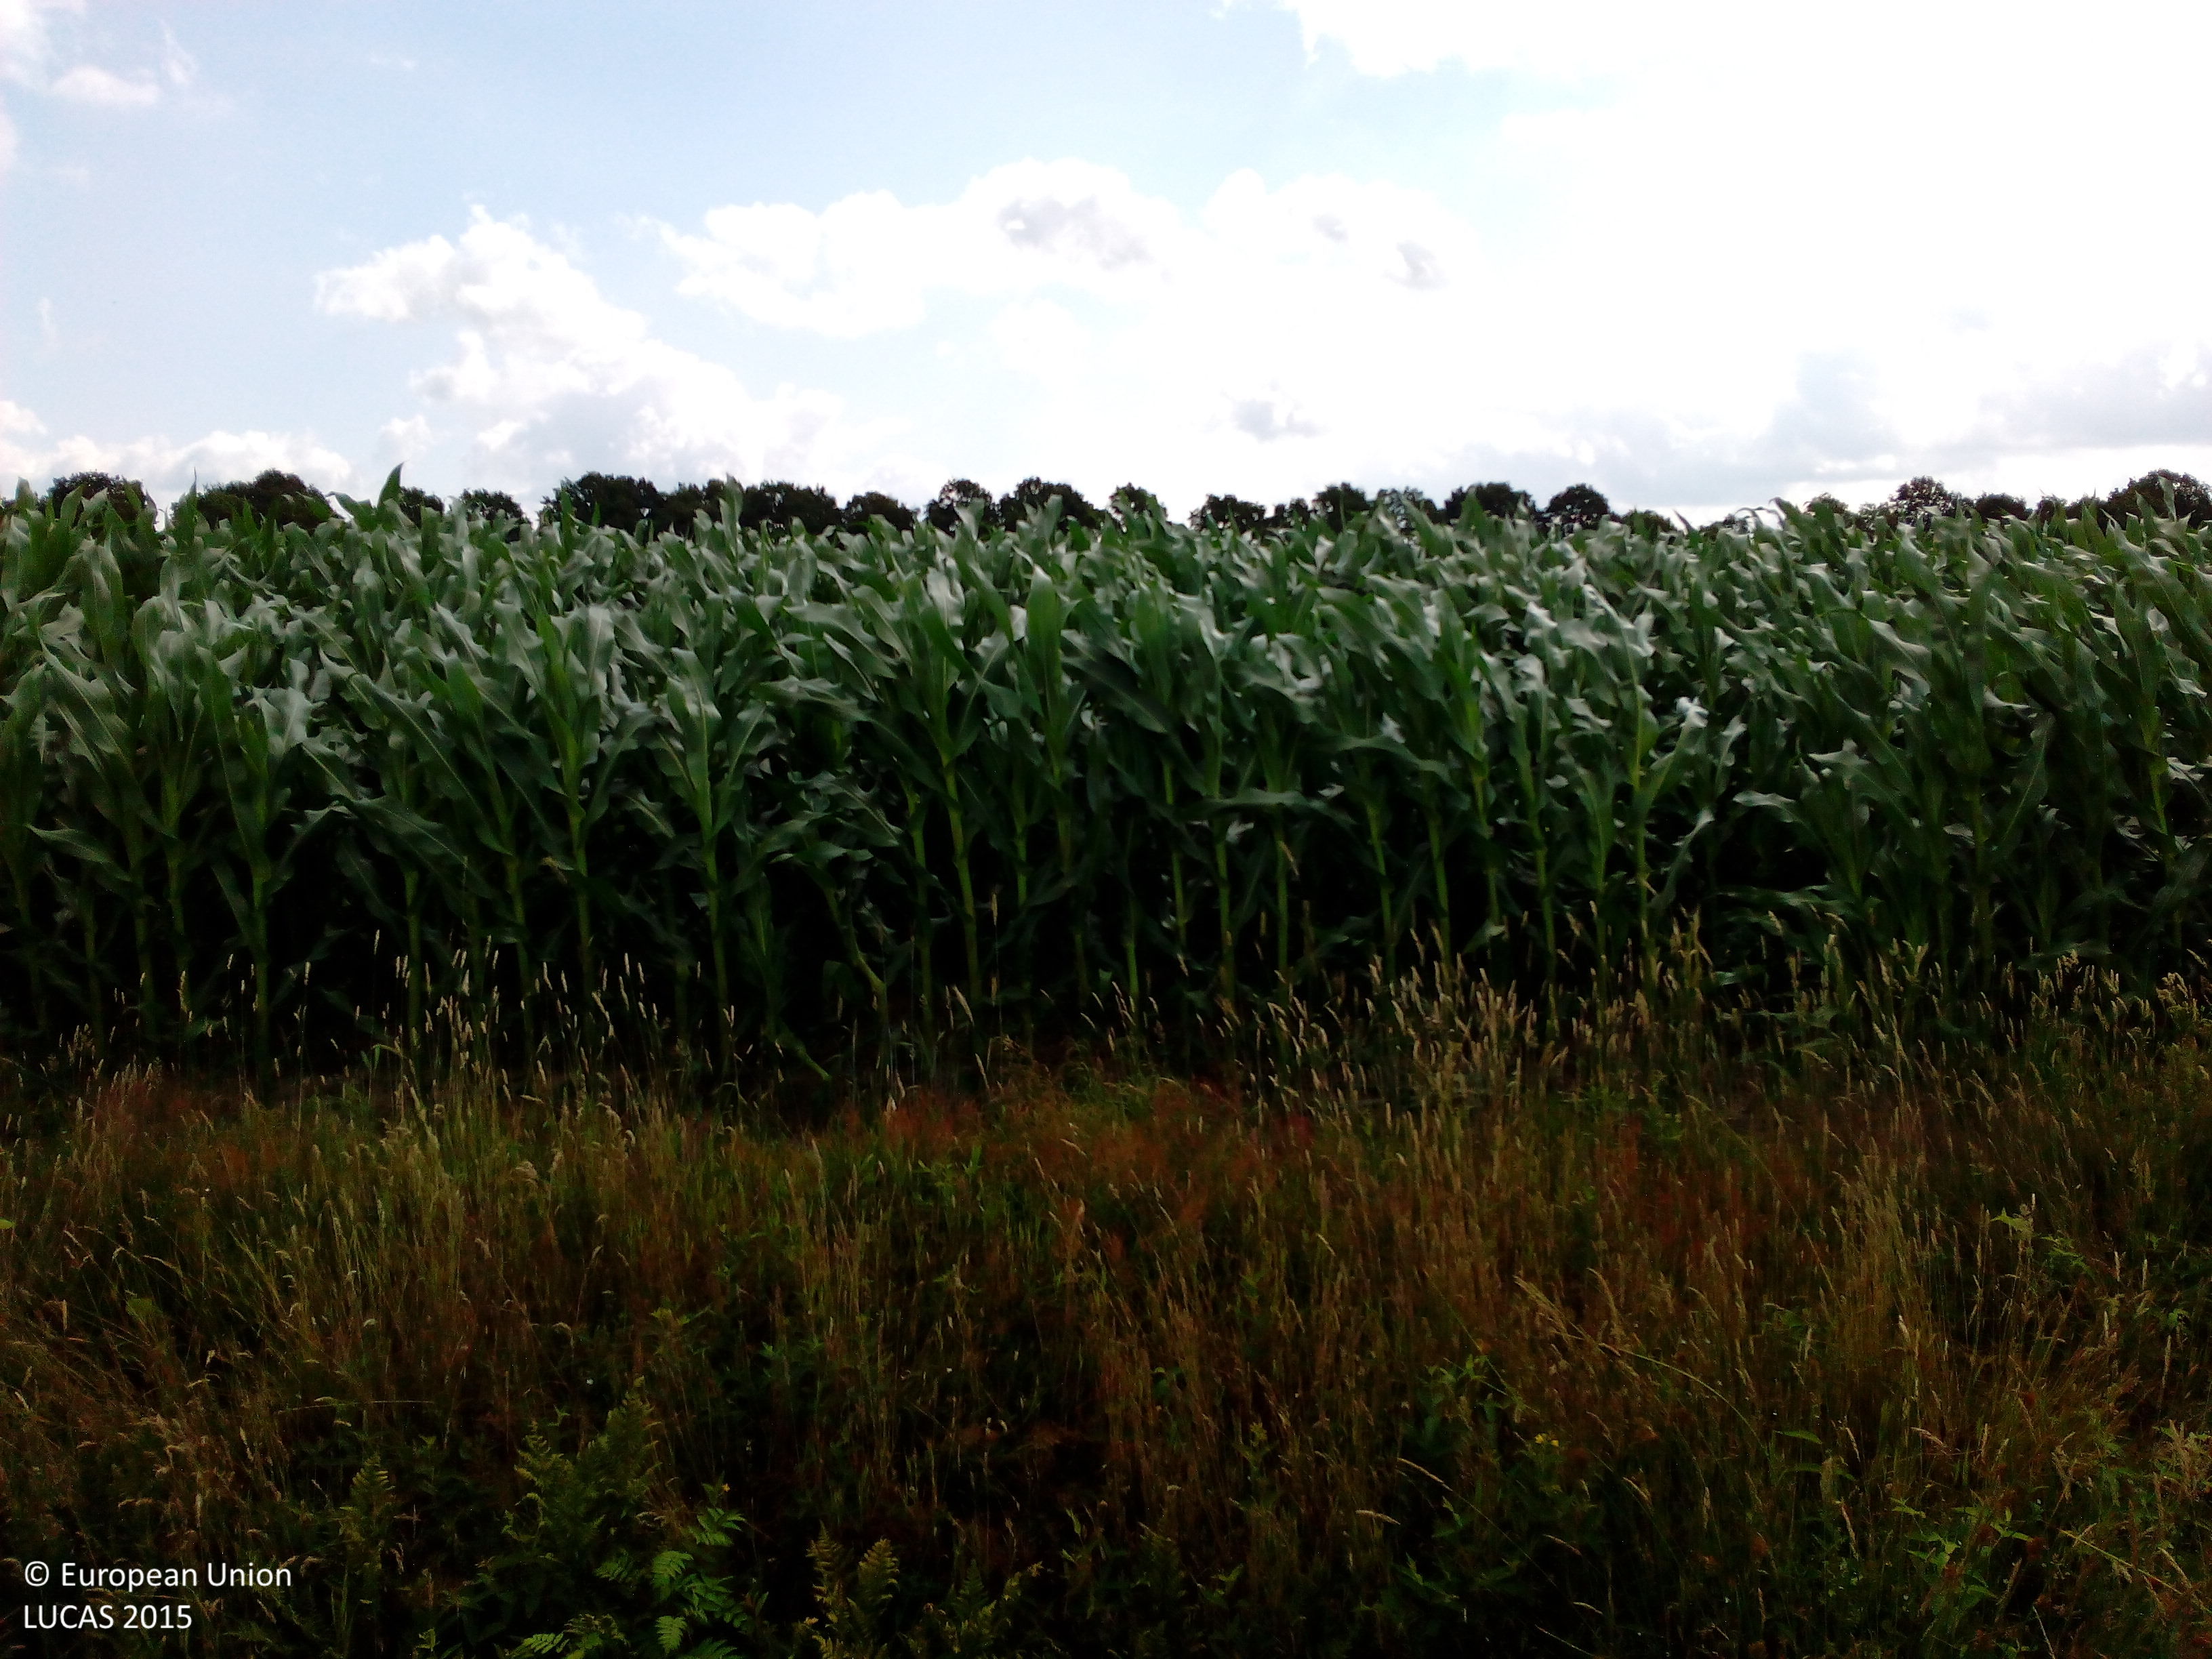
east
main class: Cropland
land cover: Barley
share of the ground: > 75 %
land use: Agriculture (excluding fallow land and kitchen gardens)
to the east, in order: Barley; Grass margins; Ditches and canals; Grass margins; Maize; Grass margins; Ditches and canals; Grass margins; Maize; Broadleaved woodland; Paved roads, cycling and walking lanes; Lines of trees; Temporary grasslands
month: July
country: DE
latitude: 53.0960
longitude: 7.8950
